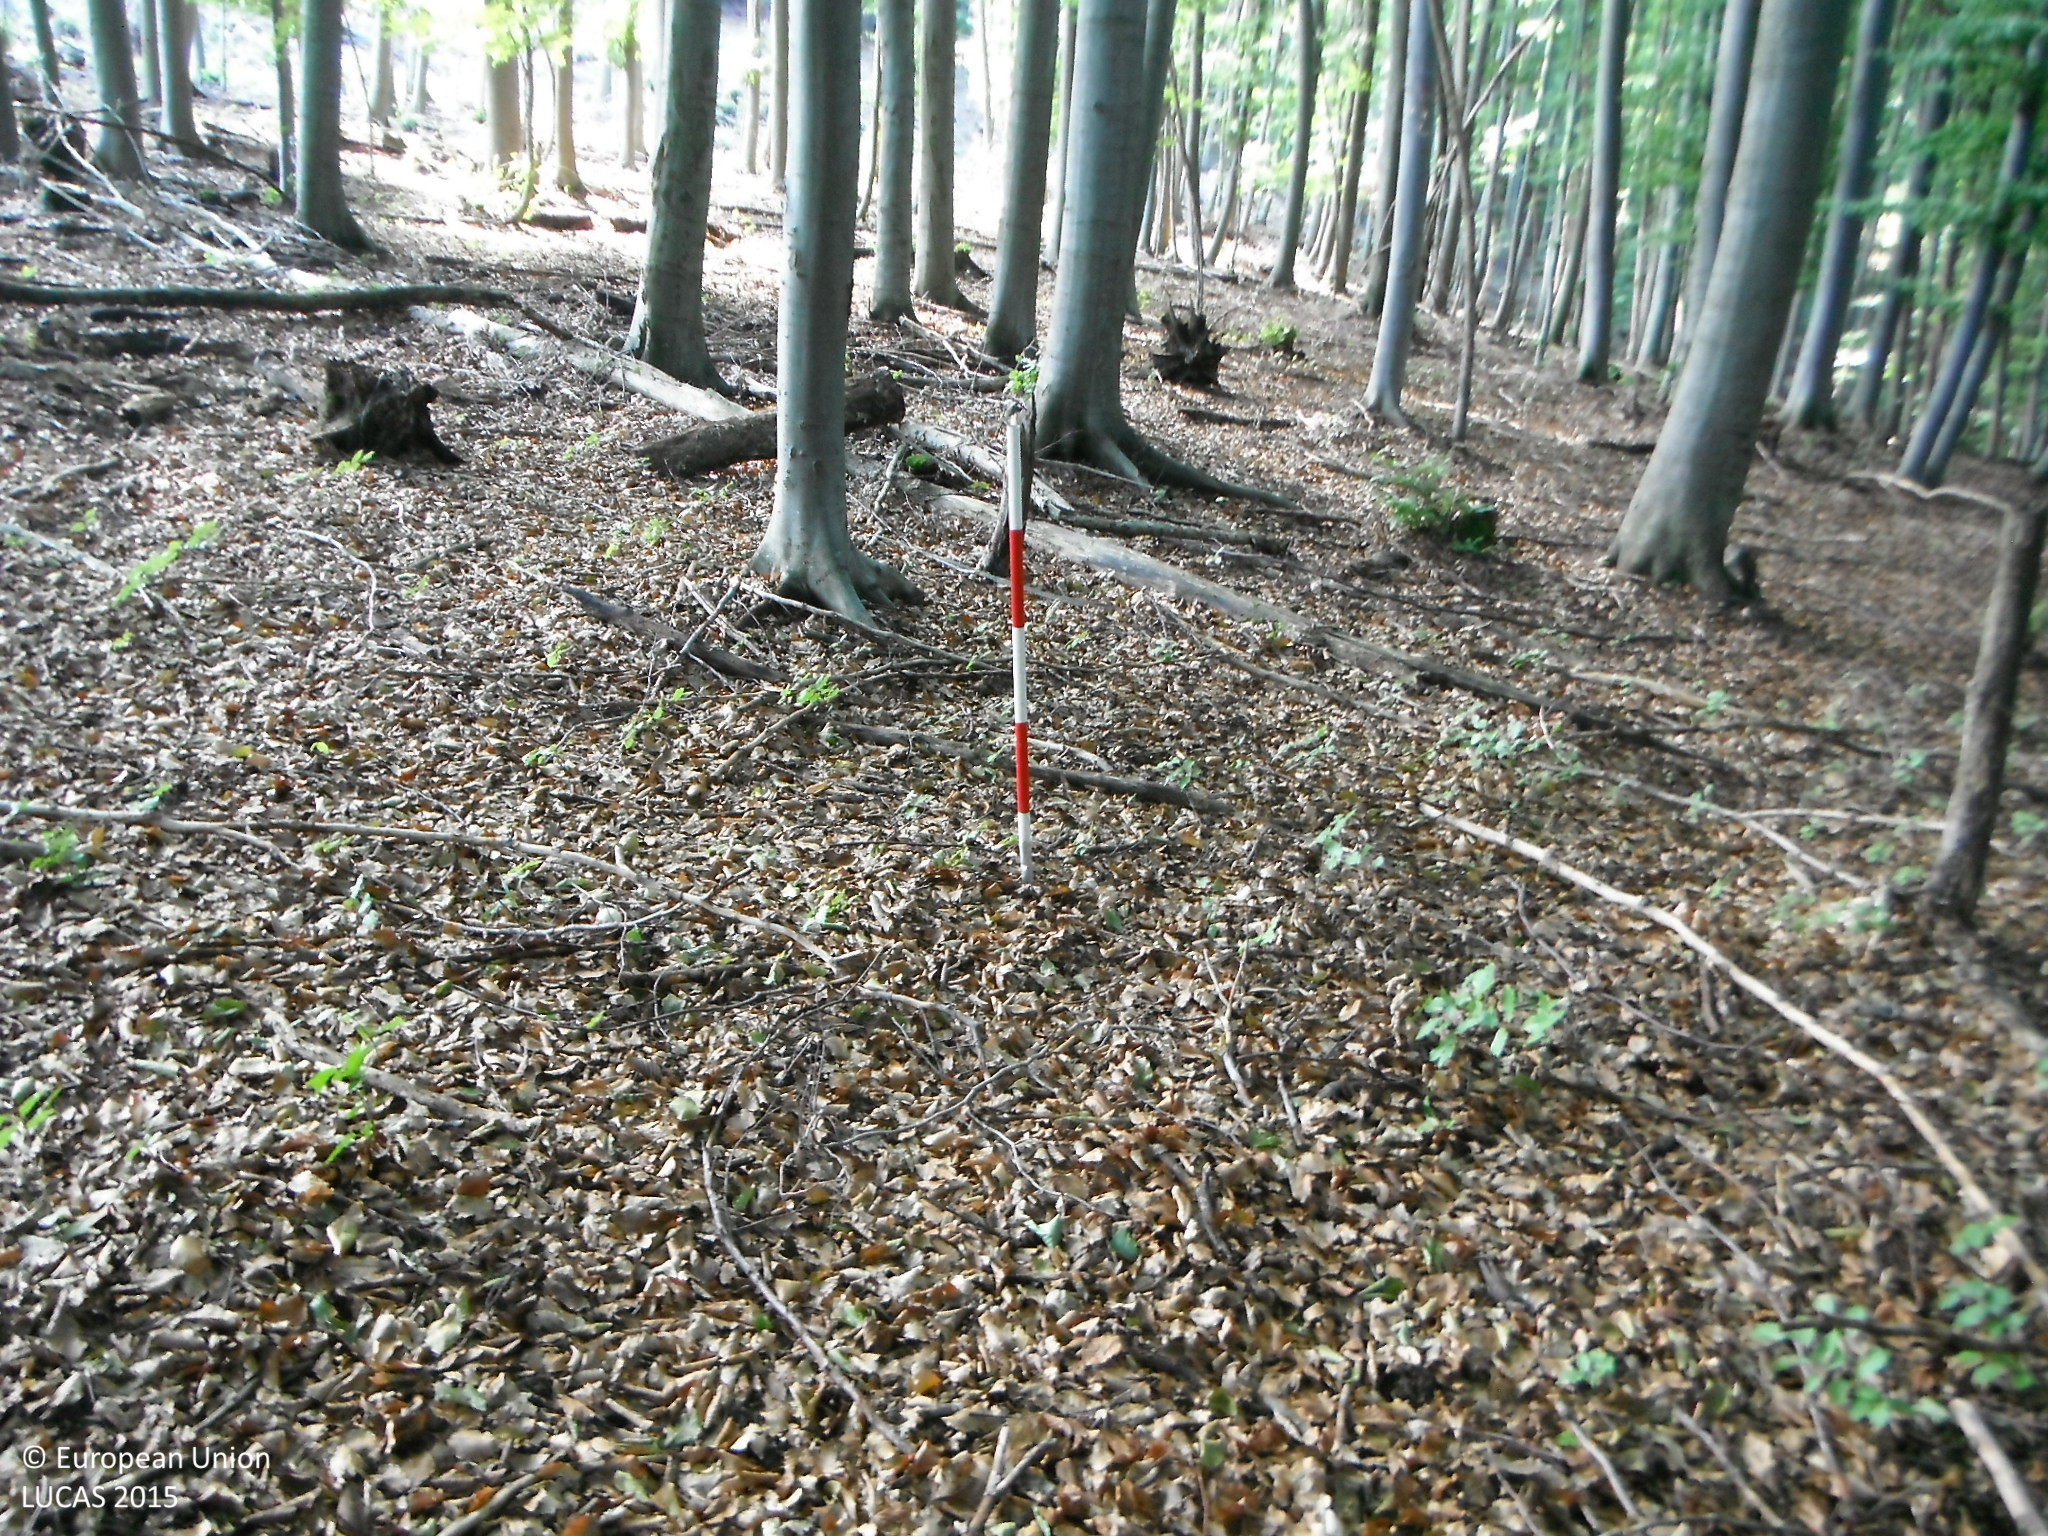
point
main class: Woodland
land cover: Broadleaved woodland
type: beech forest
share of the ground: > 75 %
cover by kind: broadleaved forest trees 90 %, consolidated bare surface 5 %
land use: Forestry
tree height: > 5 m
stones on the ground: < 10 %
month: September
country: SK
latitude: 48.7959
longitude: 18.3065
